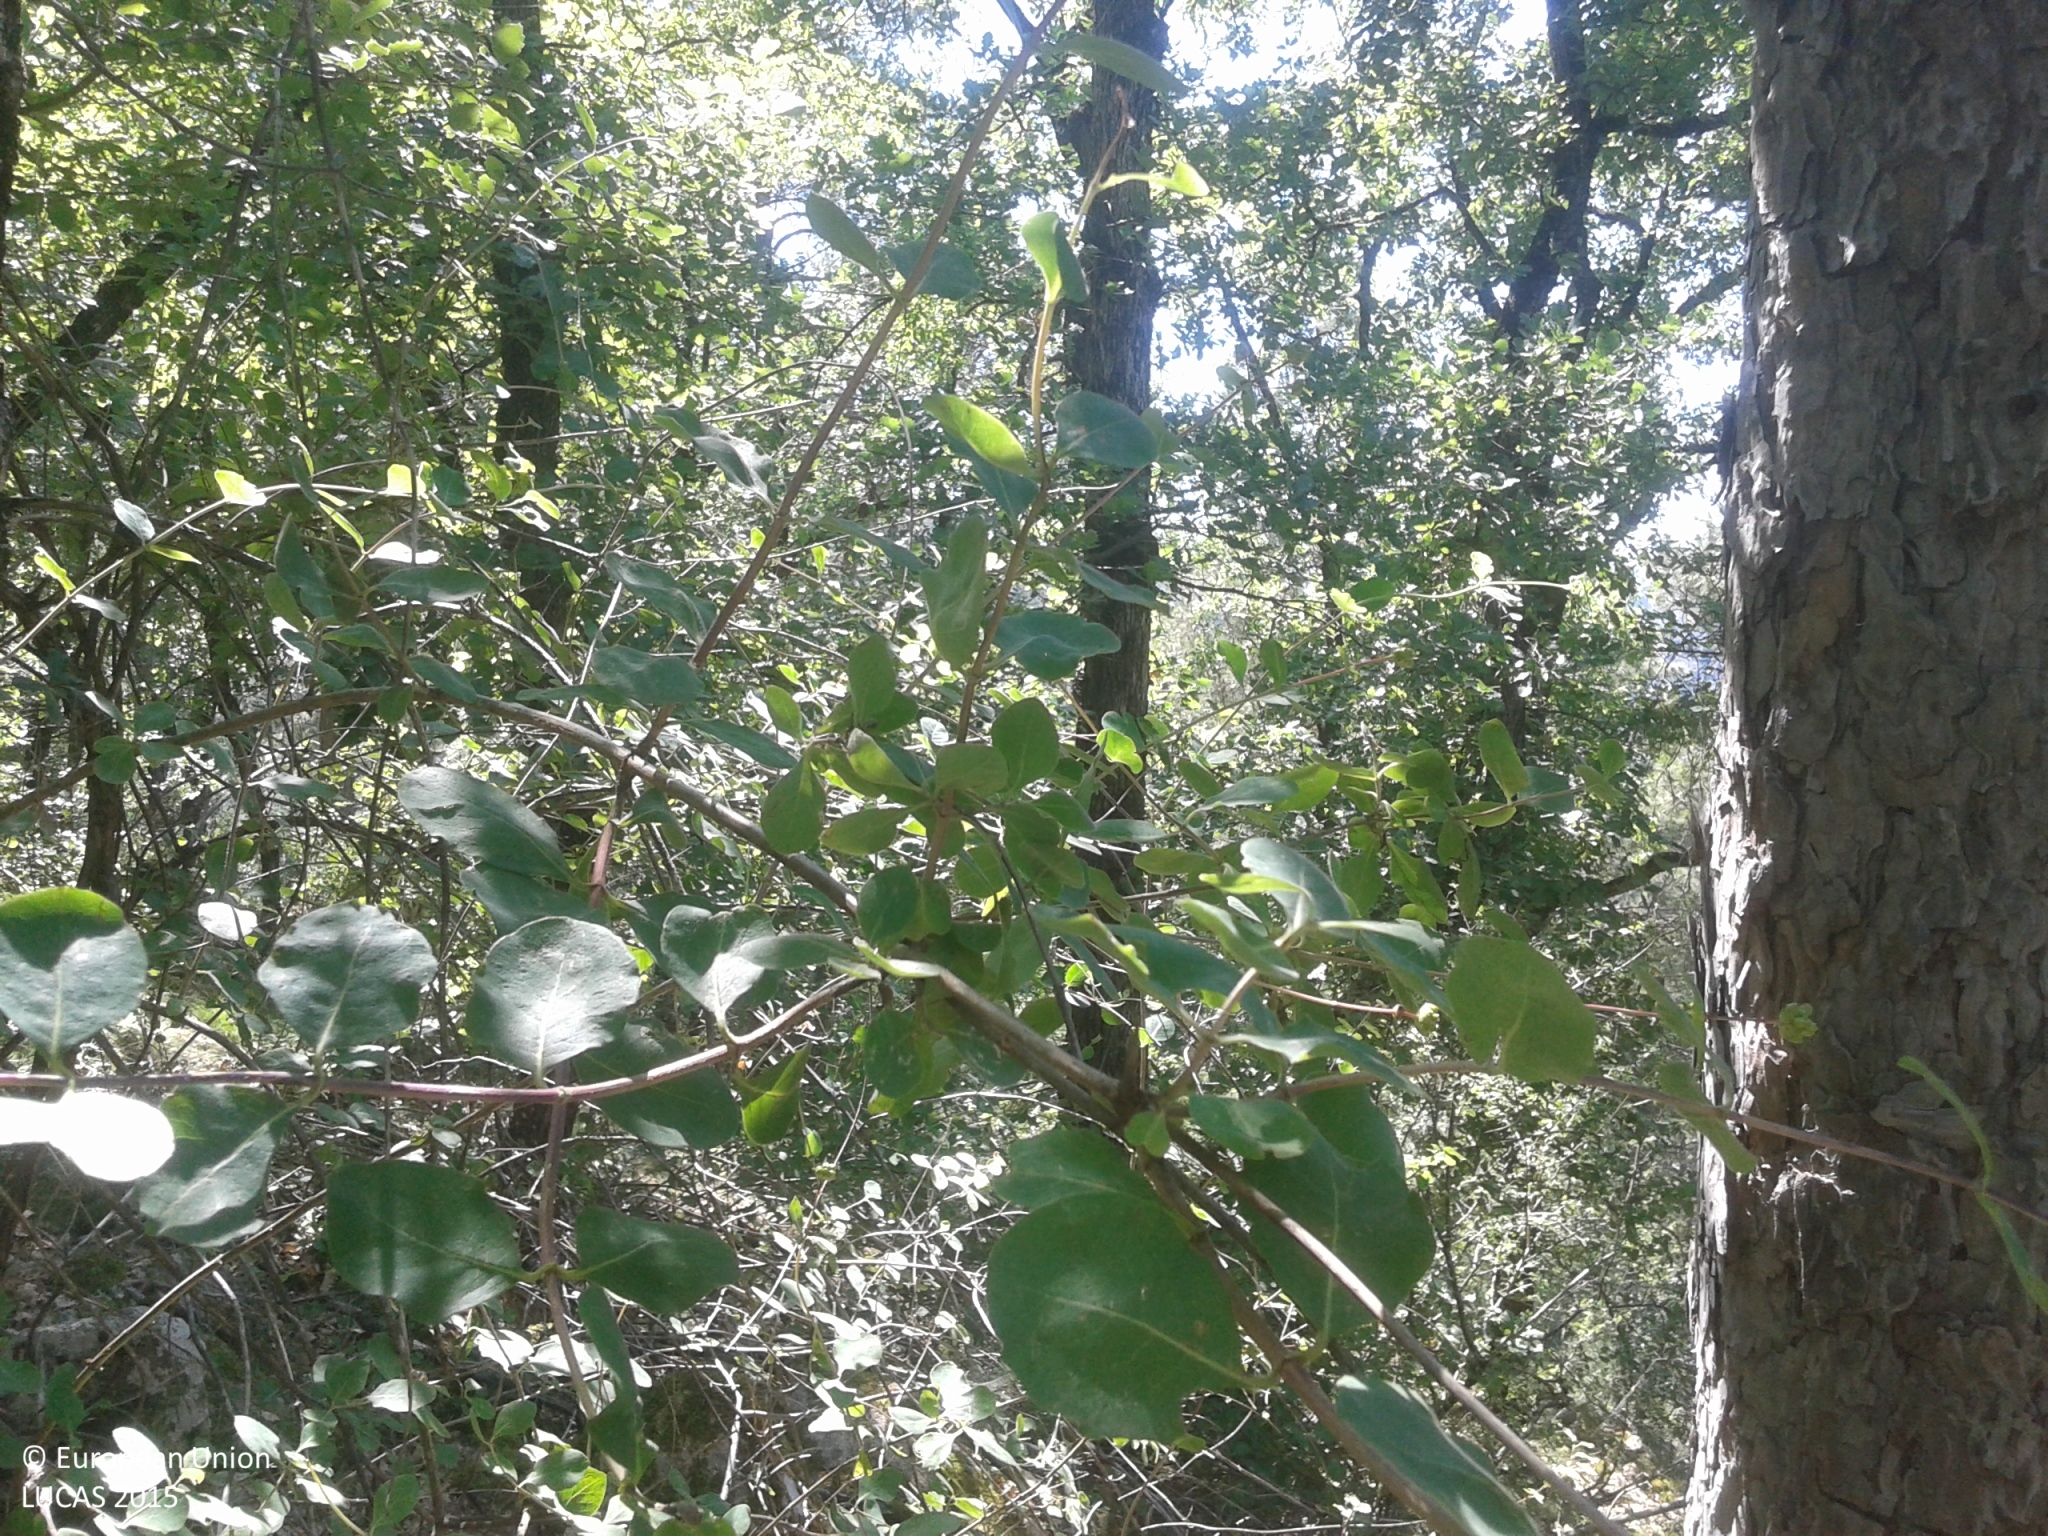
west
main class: Woodland
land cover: Other mixed woodland
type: coniferous forest of the mediterranean region
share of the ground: > 75 %
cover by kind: broadleaved forest trees 55 %, coniferous forest trees 35 %, herbaceous plants 5 %, lichens and mosses 5 %
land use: Semi-natural and natural areas not in use
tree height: > 5 m
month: June
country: ES
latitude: 42.3567
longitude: 1.5725
